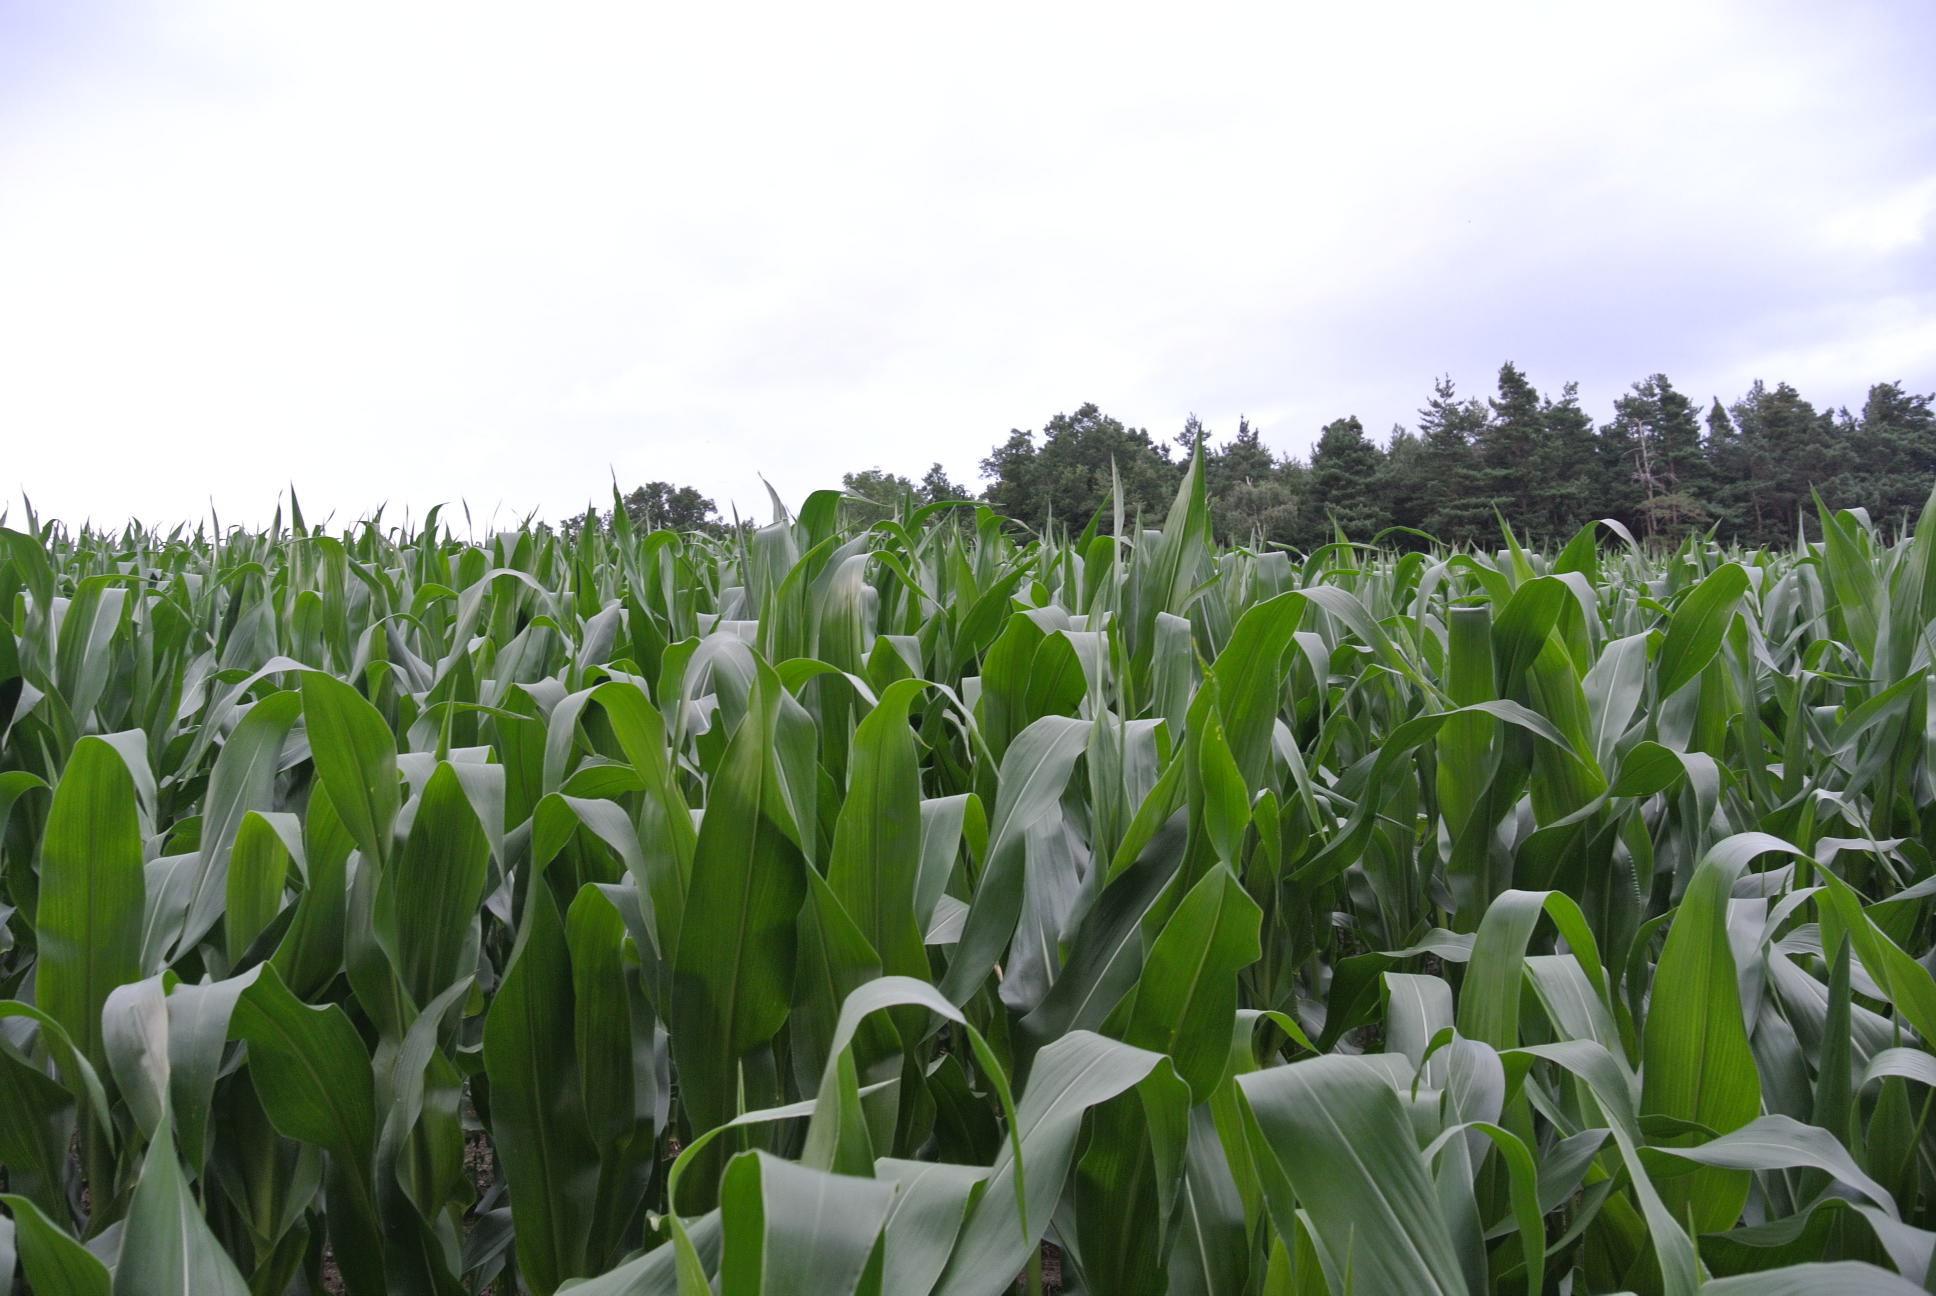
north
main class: Cropland
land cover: Maize
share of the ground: > 75 %
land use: Agriculture (excluding fallow land and kitchen gardens)
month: July
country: AT
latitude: 47.6702
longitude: 16.1962
